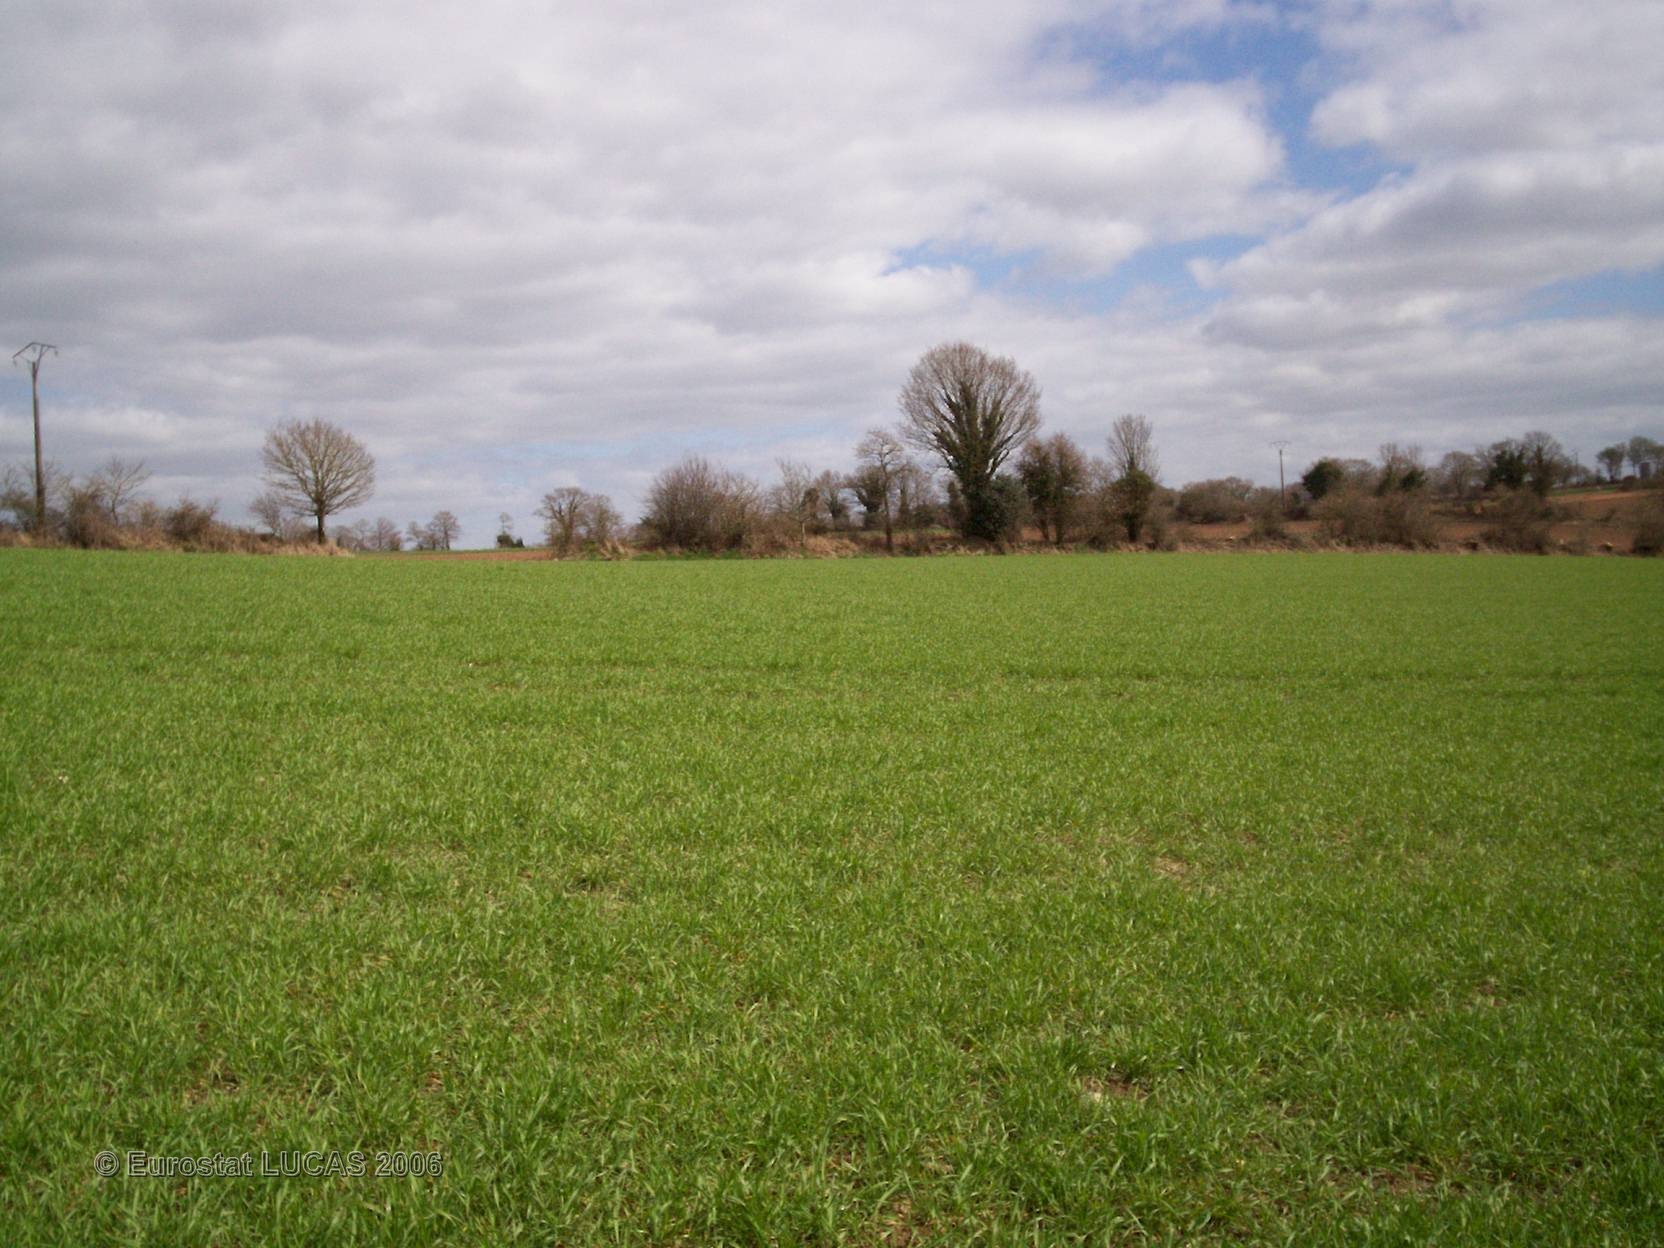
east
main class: Cropland
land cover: Common wheat
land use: Agriculture (excluding fallow land and kitchen gardens)
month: April
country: FR
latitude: 48.2178
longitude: -3.5788
